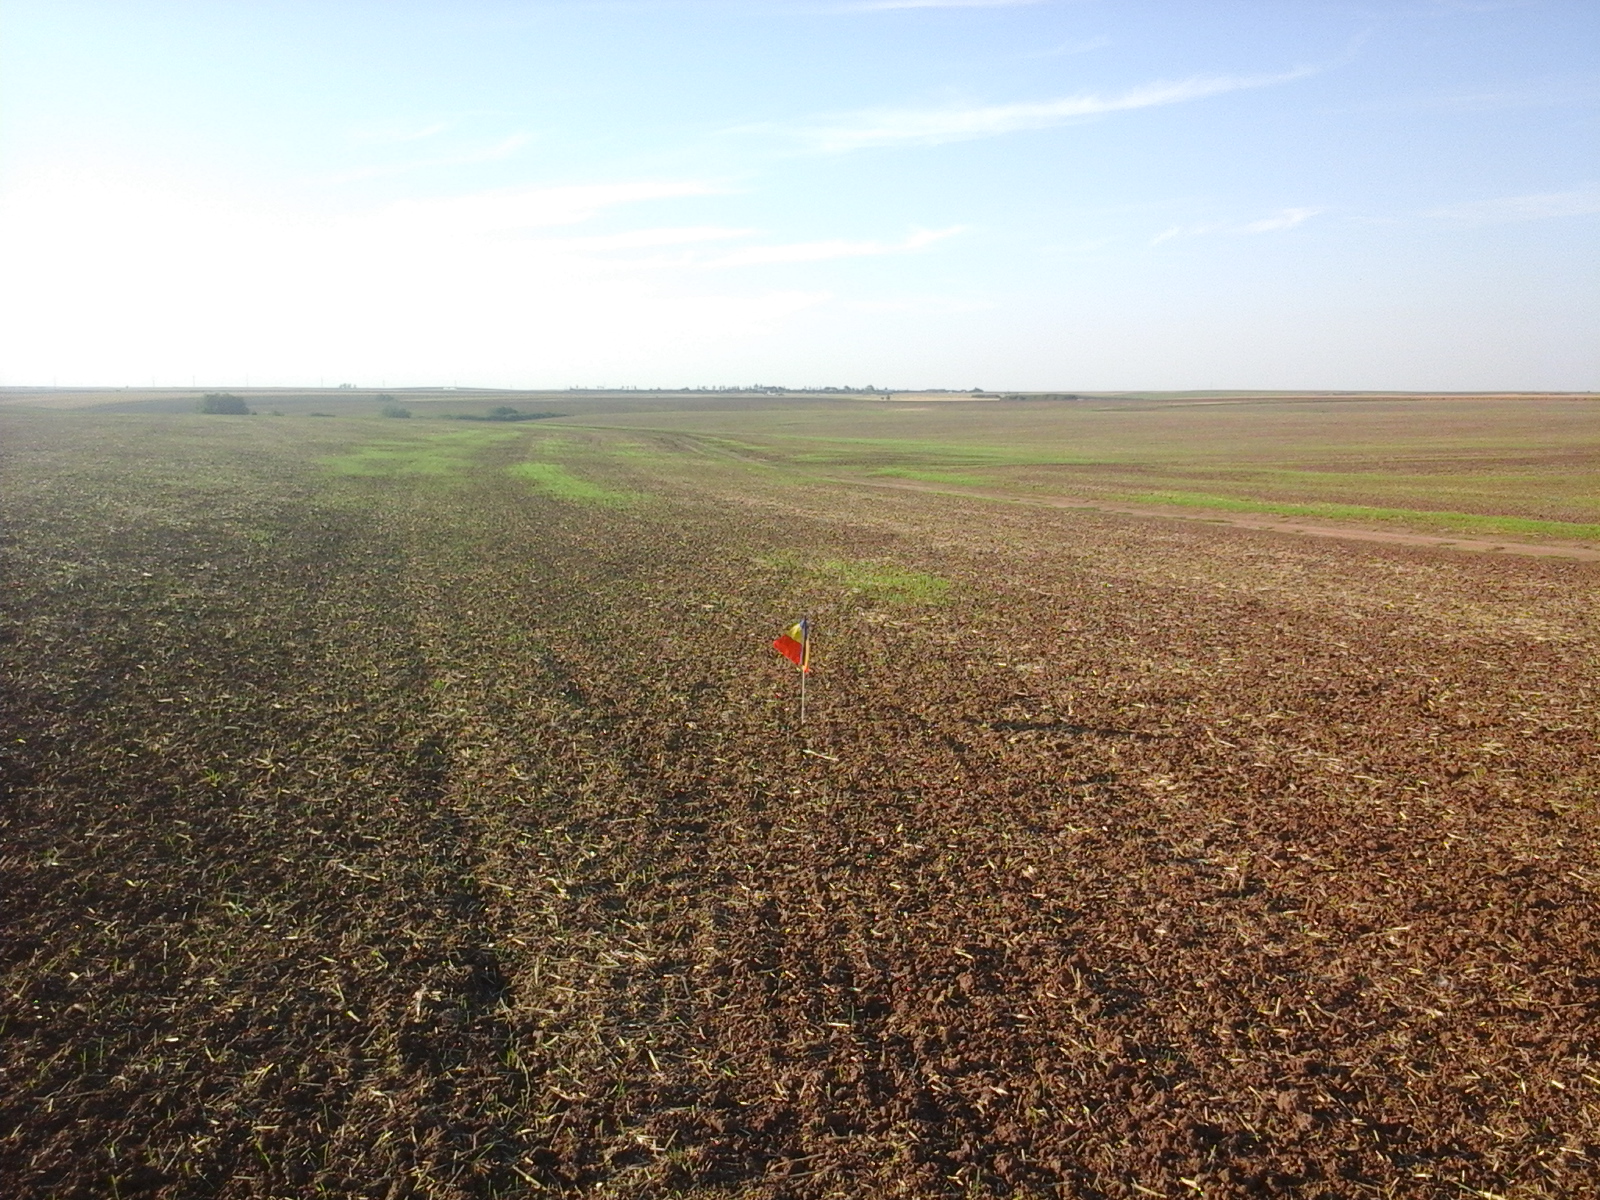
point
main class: Cropland
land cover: Common wheat
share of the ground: 10 - 25 %
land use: Agriculture (excluding fallow land and kitchen gardens)
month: August
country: RO
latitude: 46.0015
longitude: 21.3318
